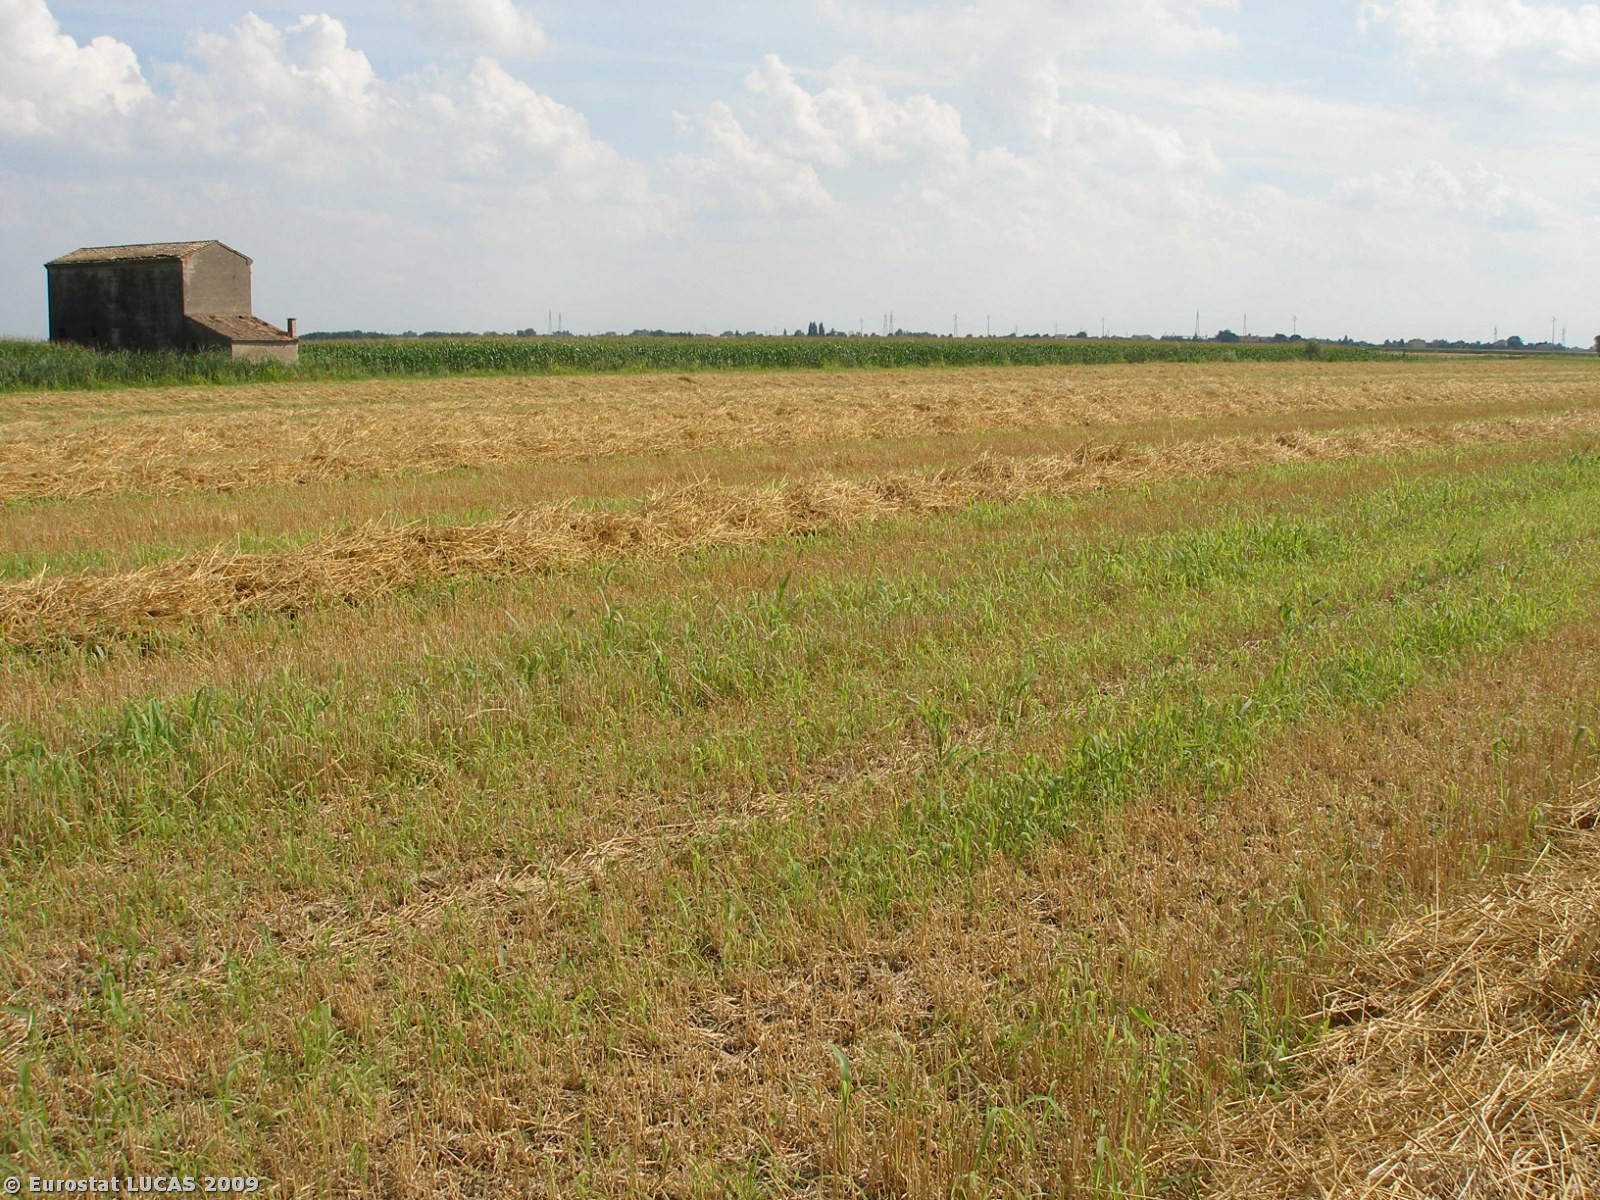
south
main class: Cropland
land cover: Maize
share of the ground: > 75 %
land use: Agriculture (excluding fallow land and kitchen gardens)
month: July
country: IT
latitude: 45.0880
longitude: 12.0419
